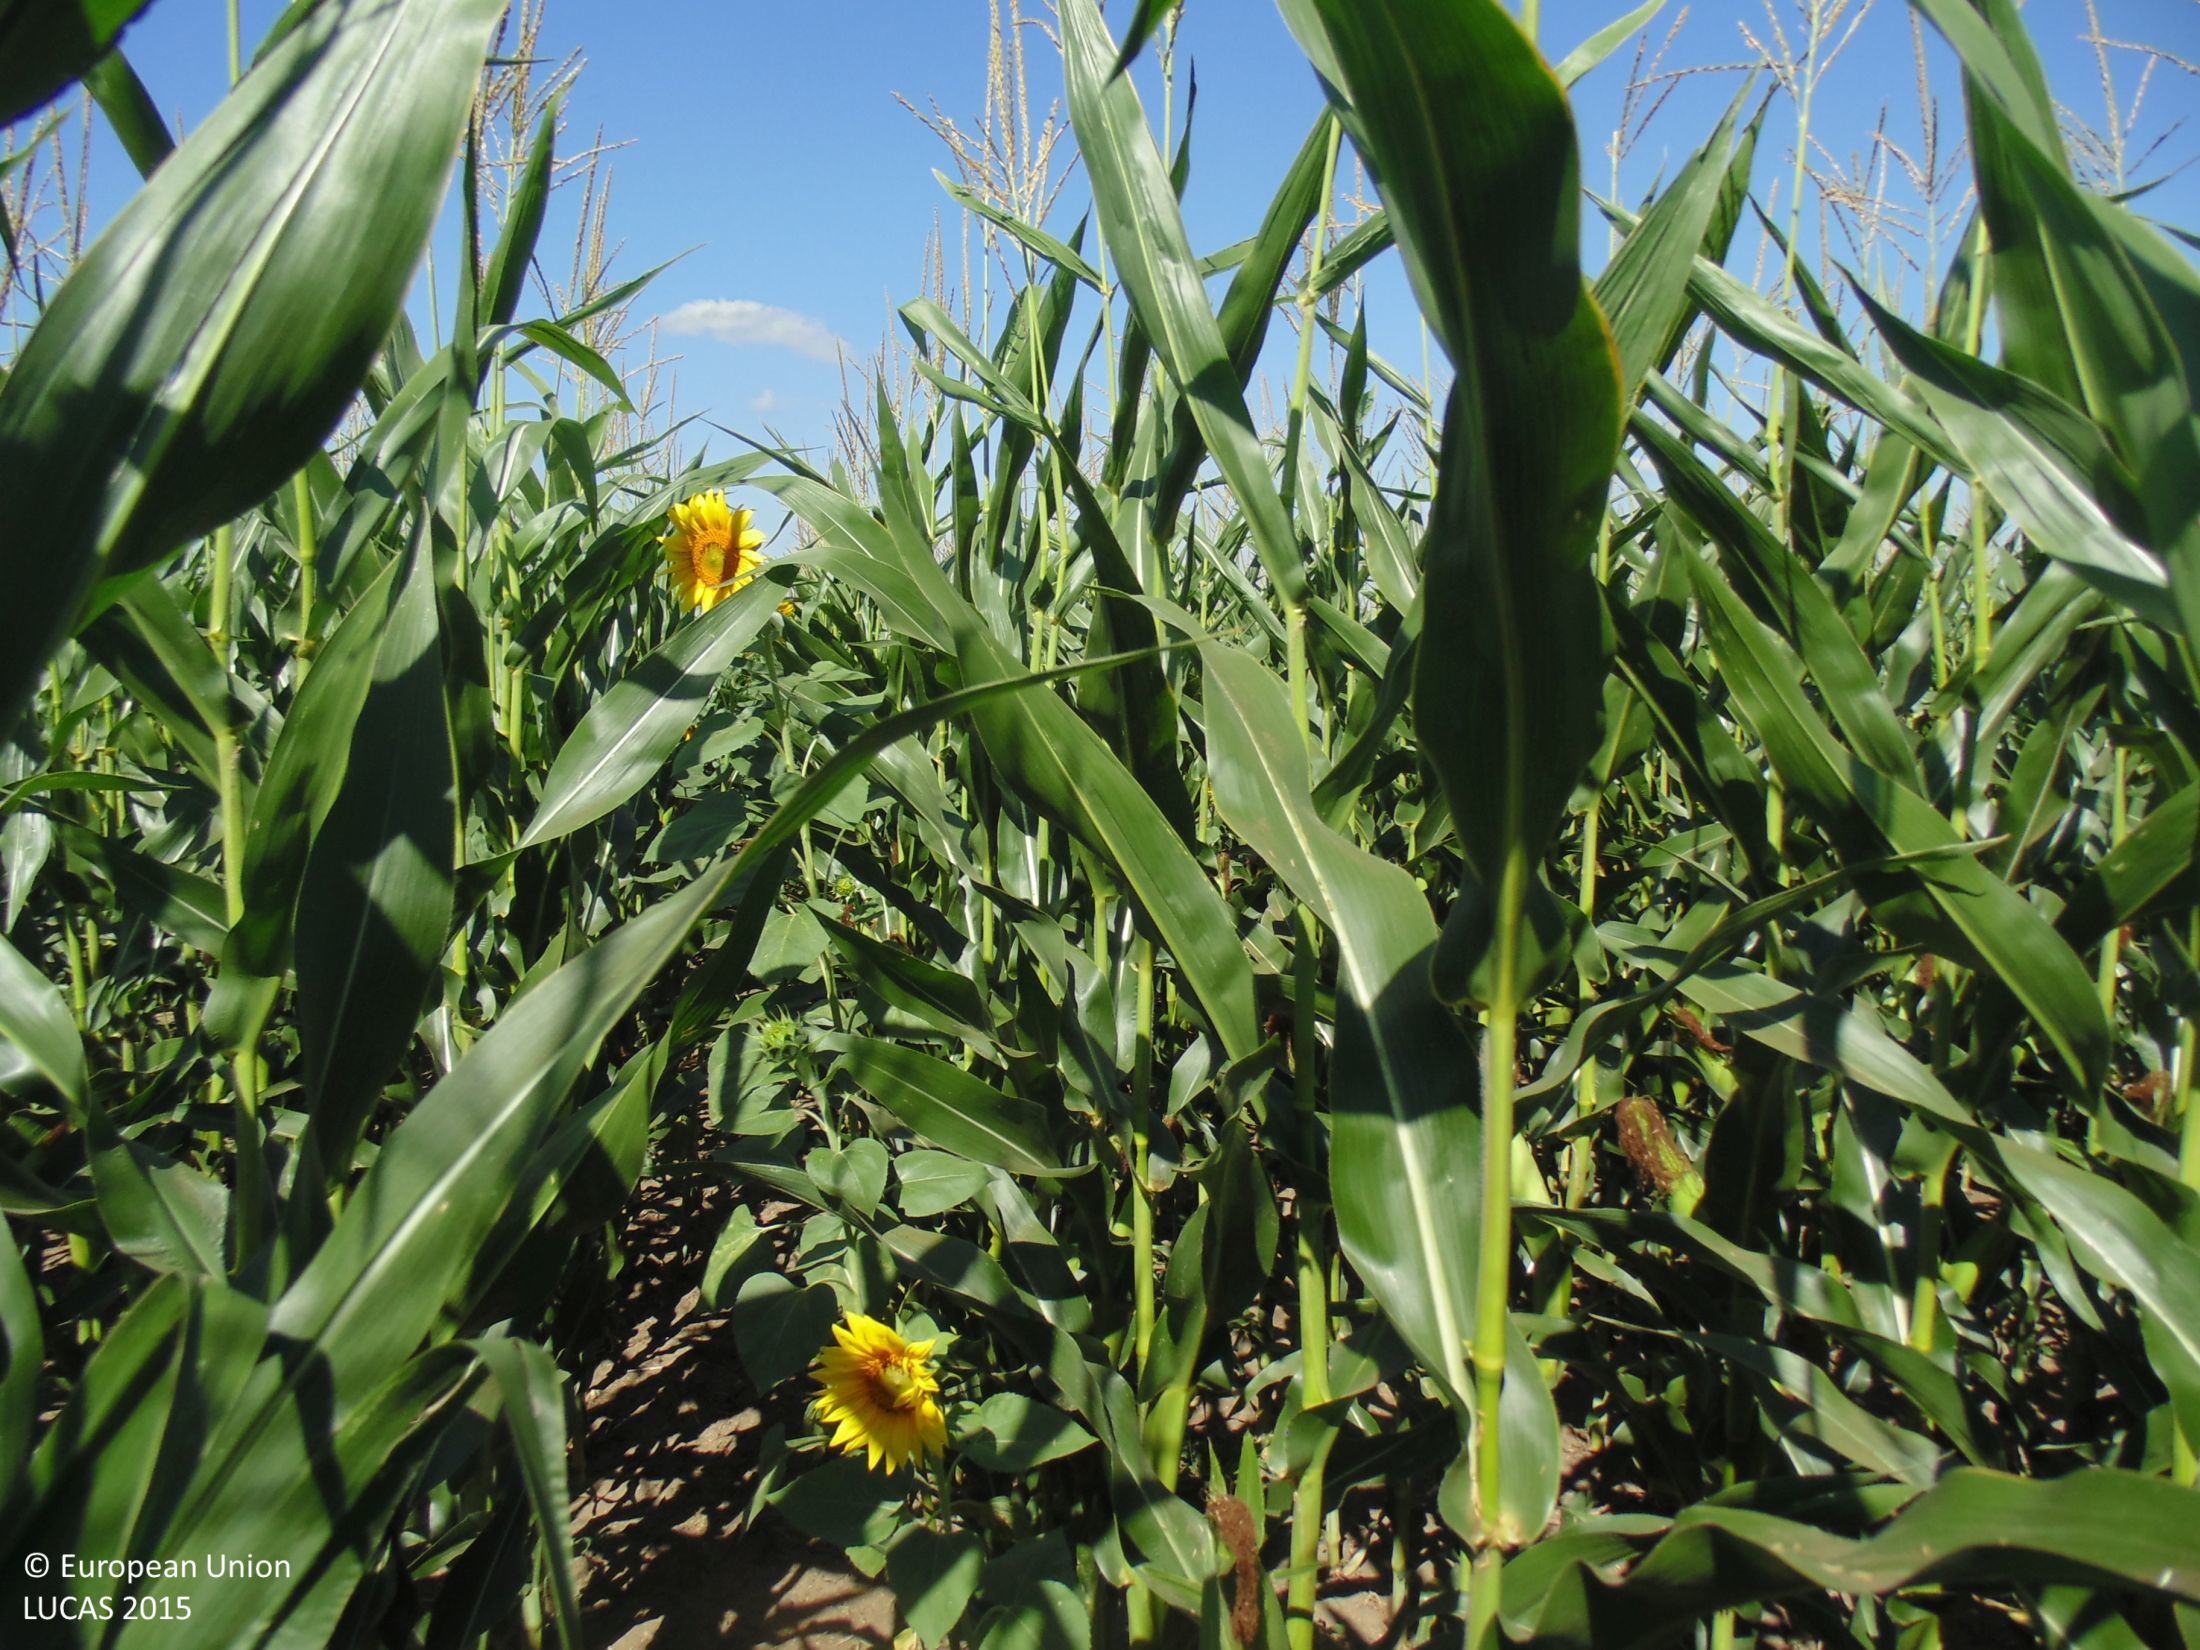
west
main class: Cropland
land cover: Maize
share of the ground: > 75 %
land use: Agriculture (excluding fallow land and kitchen gardens)
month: July
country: BG
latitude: 43.7088
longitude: 27.8534
